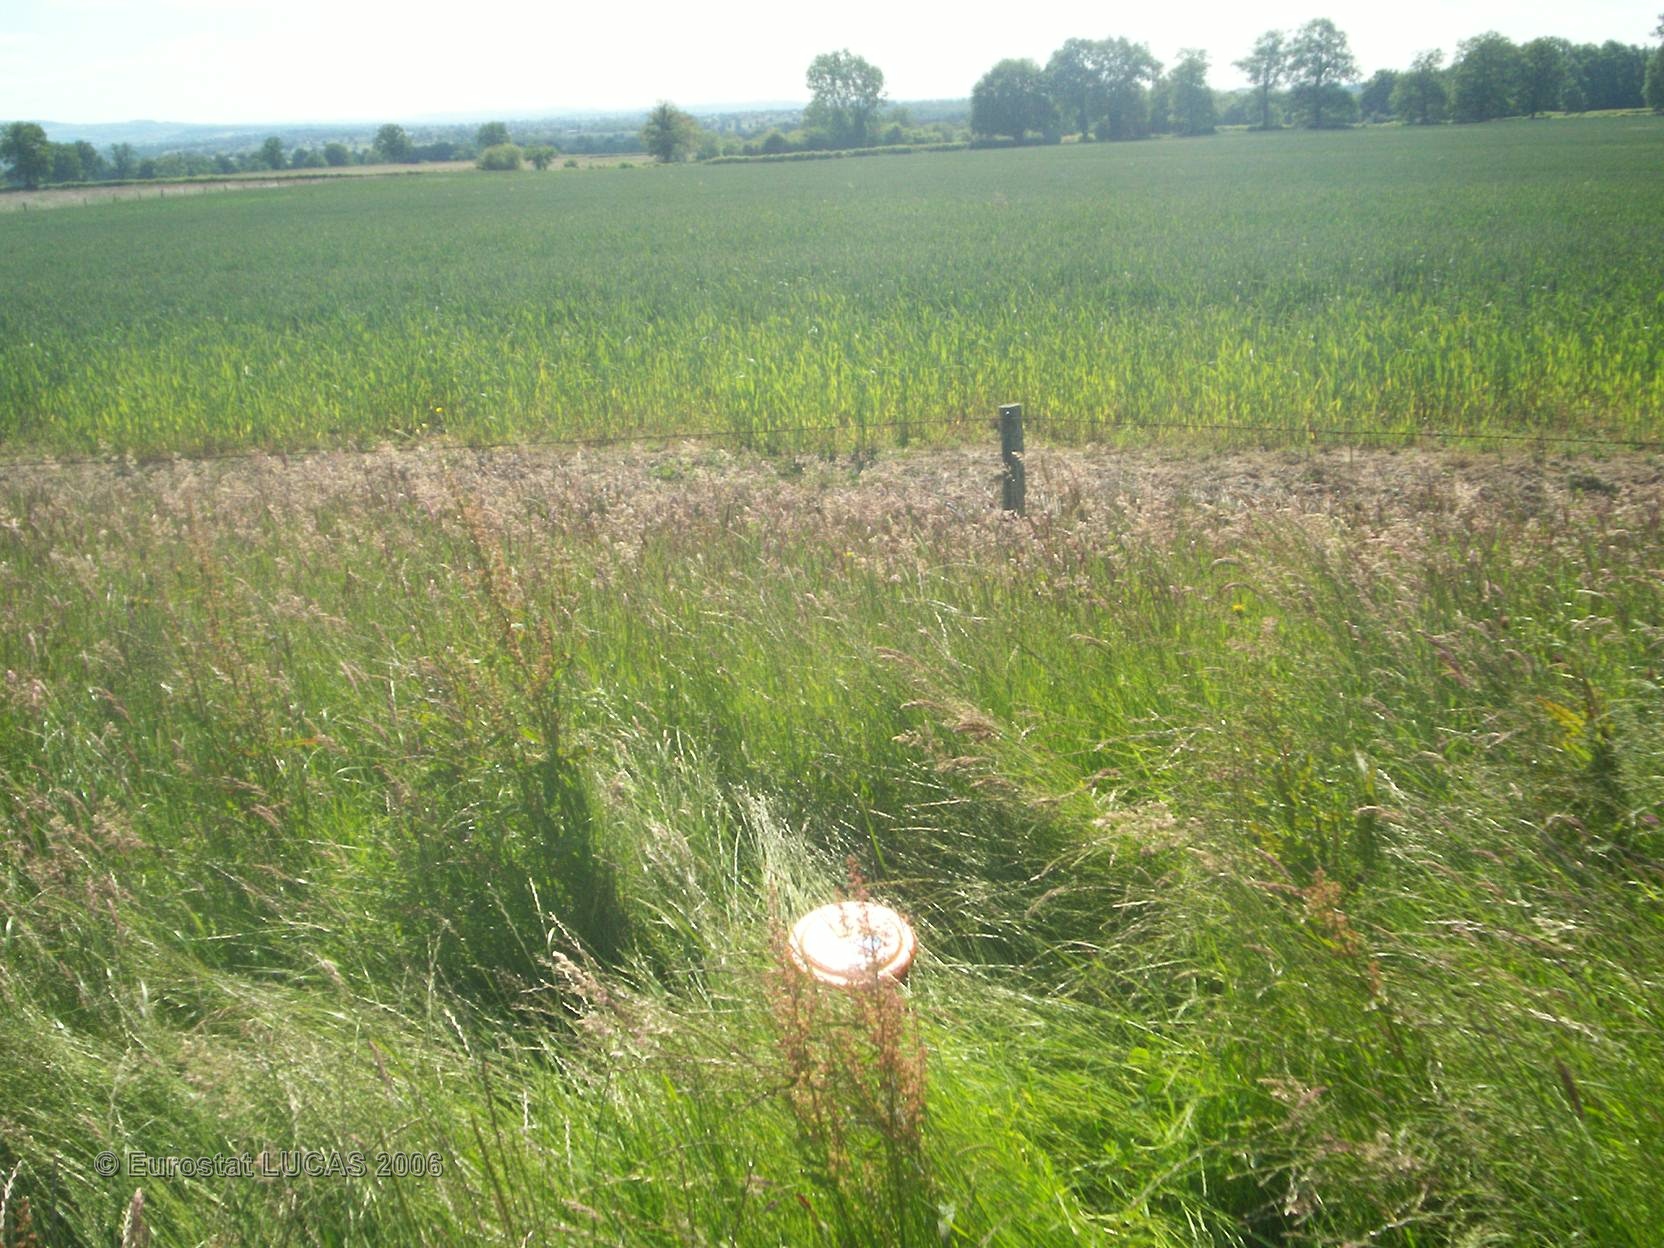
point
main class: Grassland
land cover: Grassland without tree/shrub cover
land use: Agriculture (excluding fallow land and kitchen gardens)
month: June
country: FR
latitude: 46.3109
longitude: 3.1289
